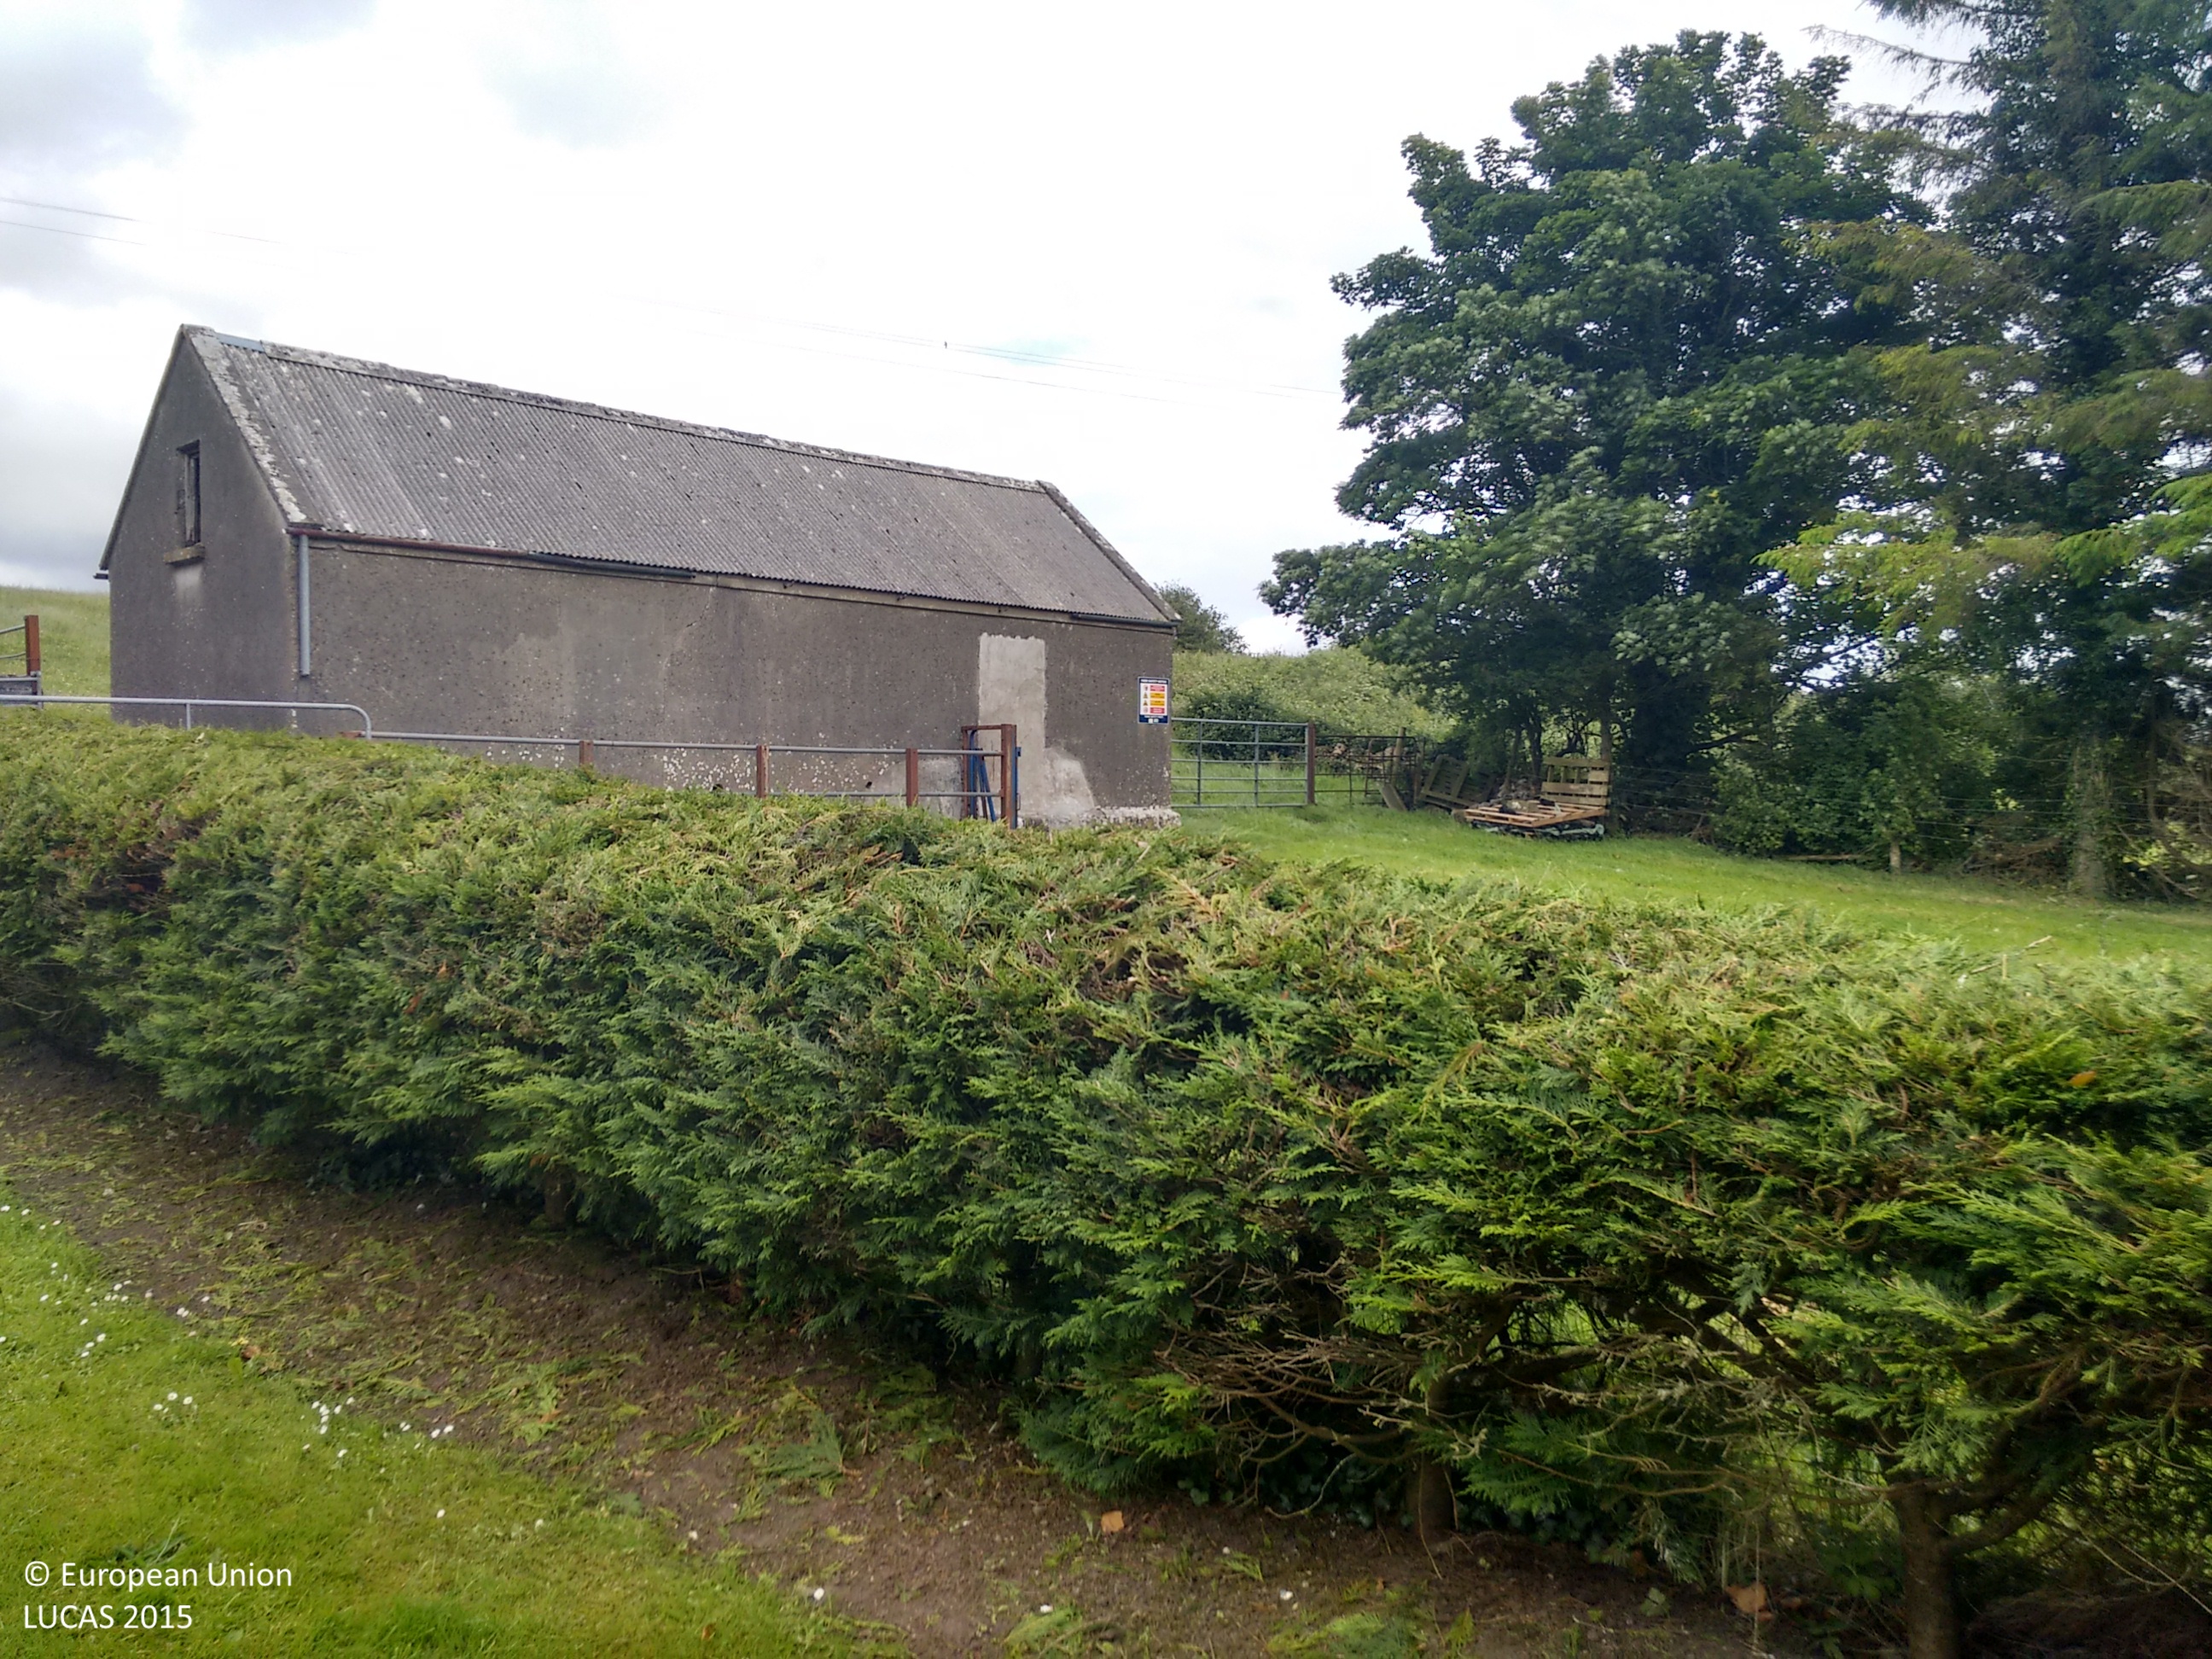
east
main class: Grassland
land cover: Grassland without tree/shrub cover
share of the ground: > 75 %
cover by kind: herbaceous plants 100 %
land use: Agriculture (excluding fallow land and kitchen gardens)
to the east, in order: Grassland without tree/shrub cover; Artificial constructions in urban areas; Dry stone walls; Abandoned hedges; Rocks and stones; Electric lines; Rocks and stones; Fences; Dry stone walls; Grassland without tree/shrub cover; Electric lines; Grassland without tree/shrub cover; Fences; Dry stone walls; Grassland without tree/shrub cover
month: July
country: IE
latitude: 53.6567
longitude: -8.8638
